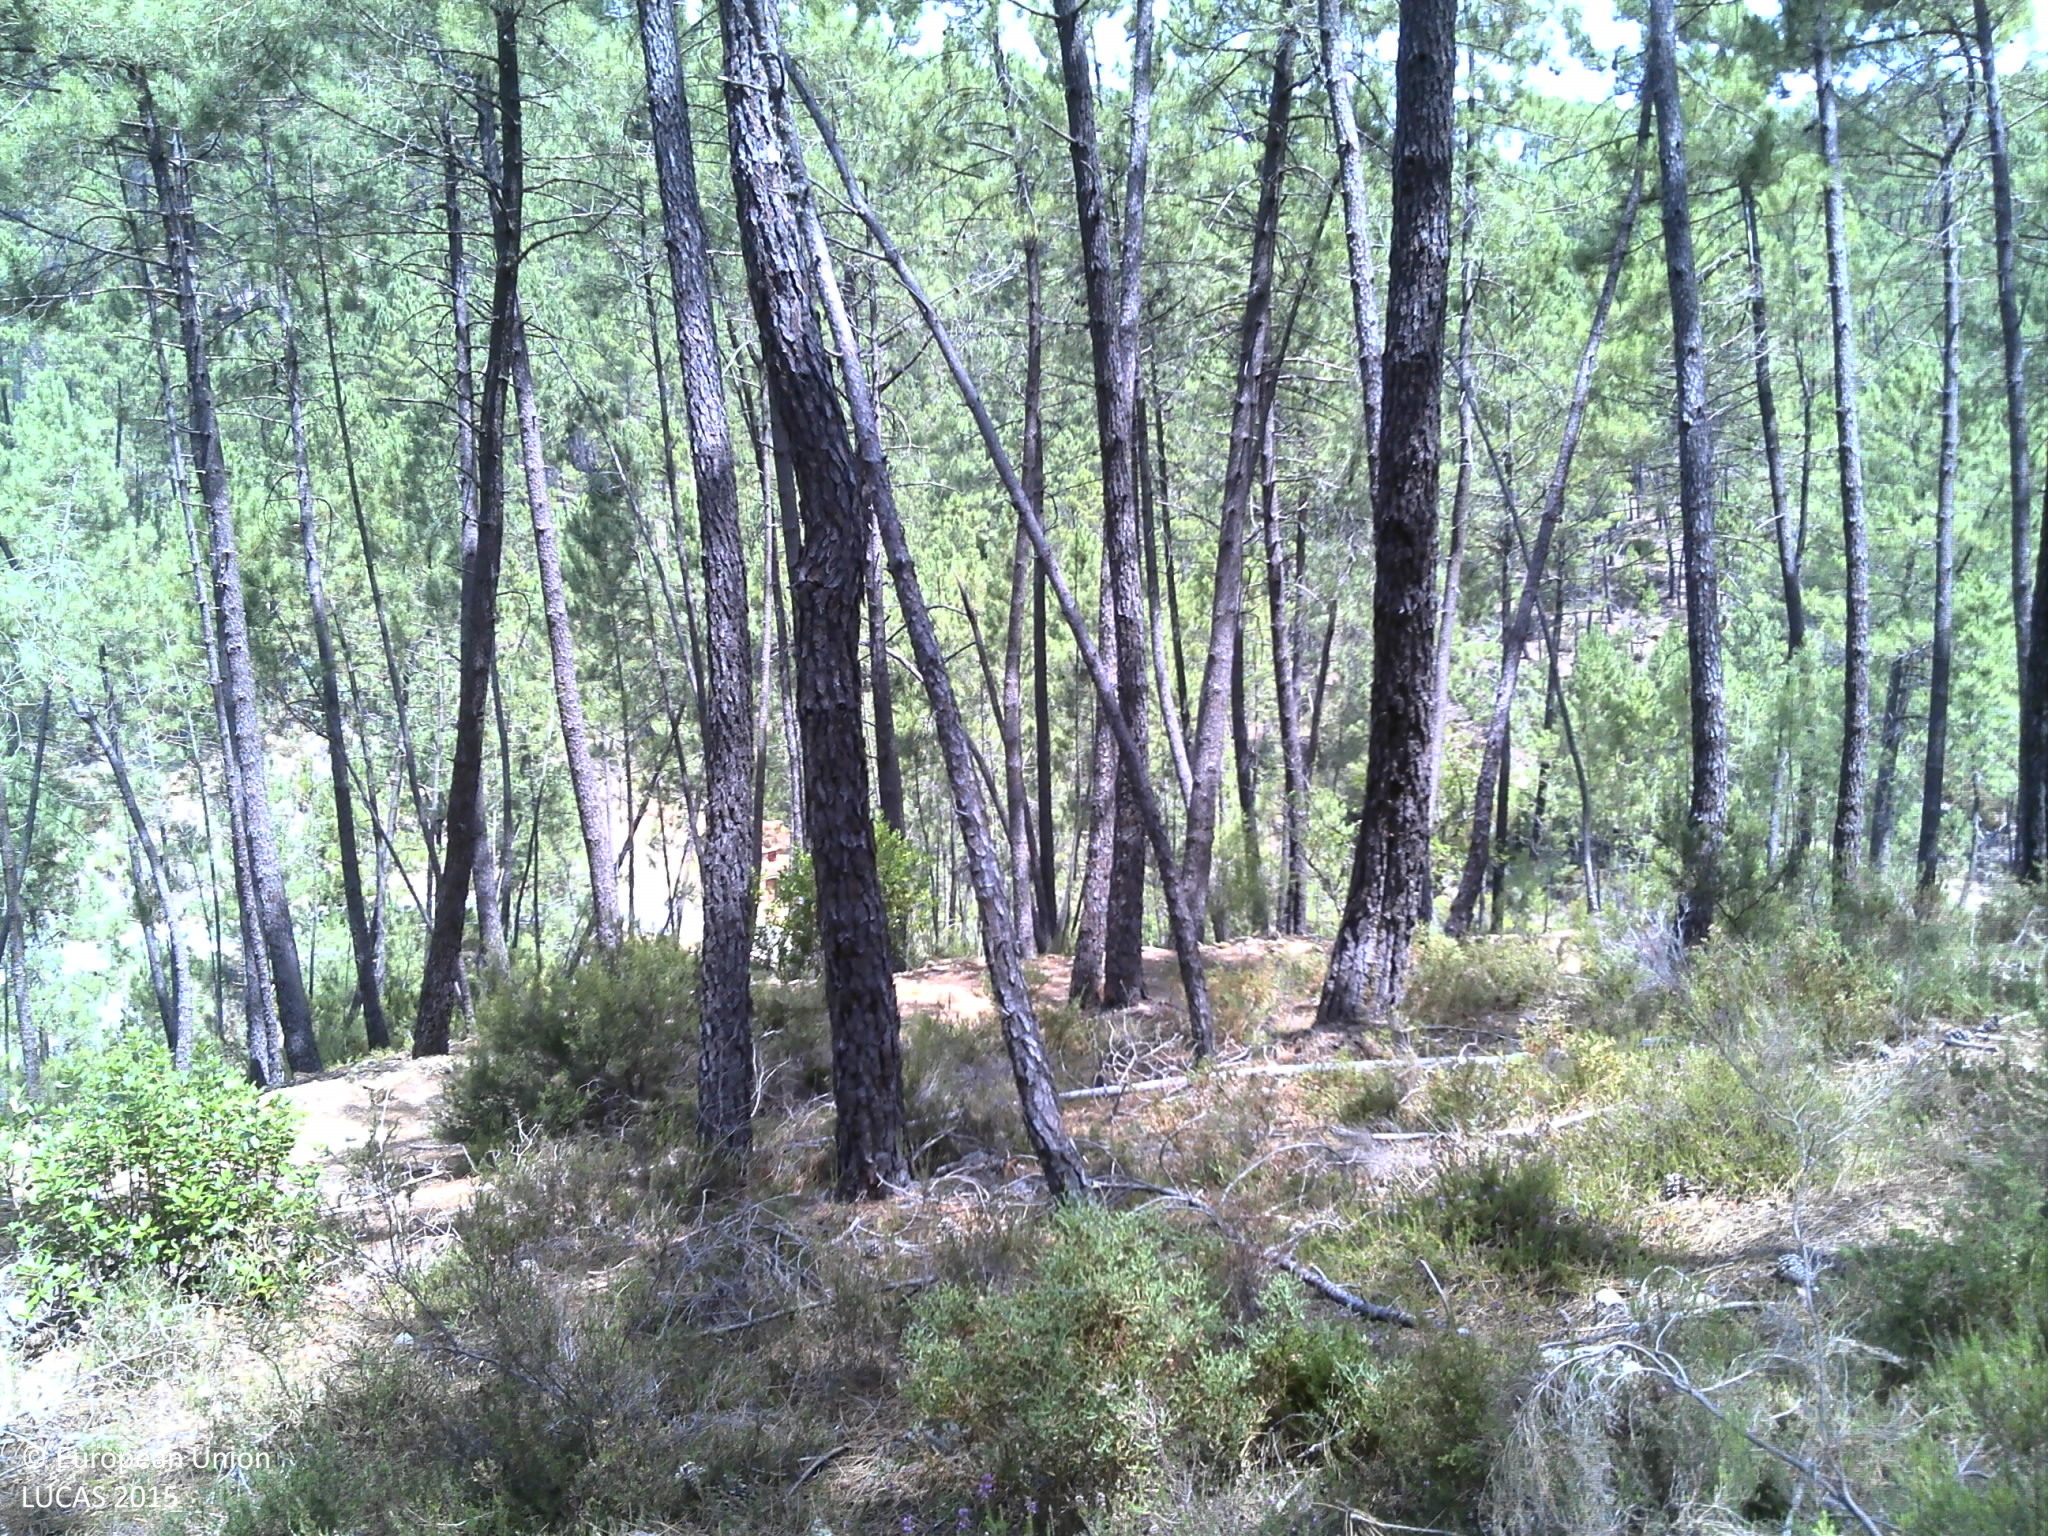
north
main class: Woodland
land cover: Pine dominated coniferous woodland
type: coniferous forest of the mediterranean region
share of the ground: 10 - 25 %
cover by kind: shrubs 50 %, unconsolidated bare surface 35 %, coniferous forest trees 15 %
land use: Forestry
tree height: > 5 m
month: July
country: PT
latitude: 39.8768
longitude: -7.8220
